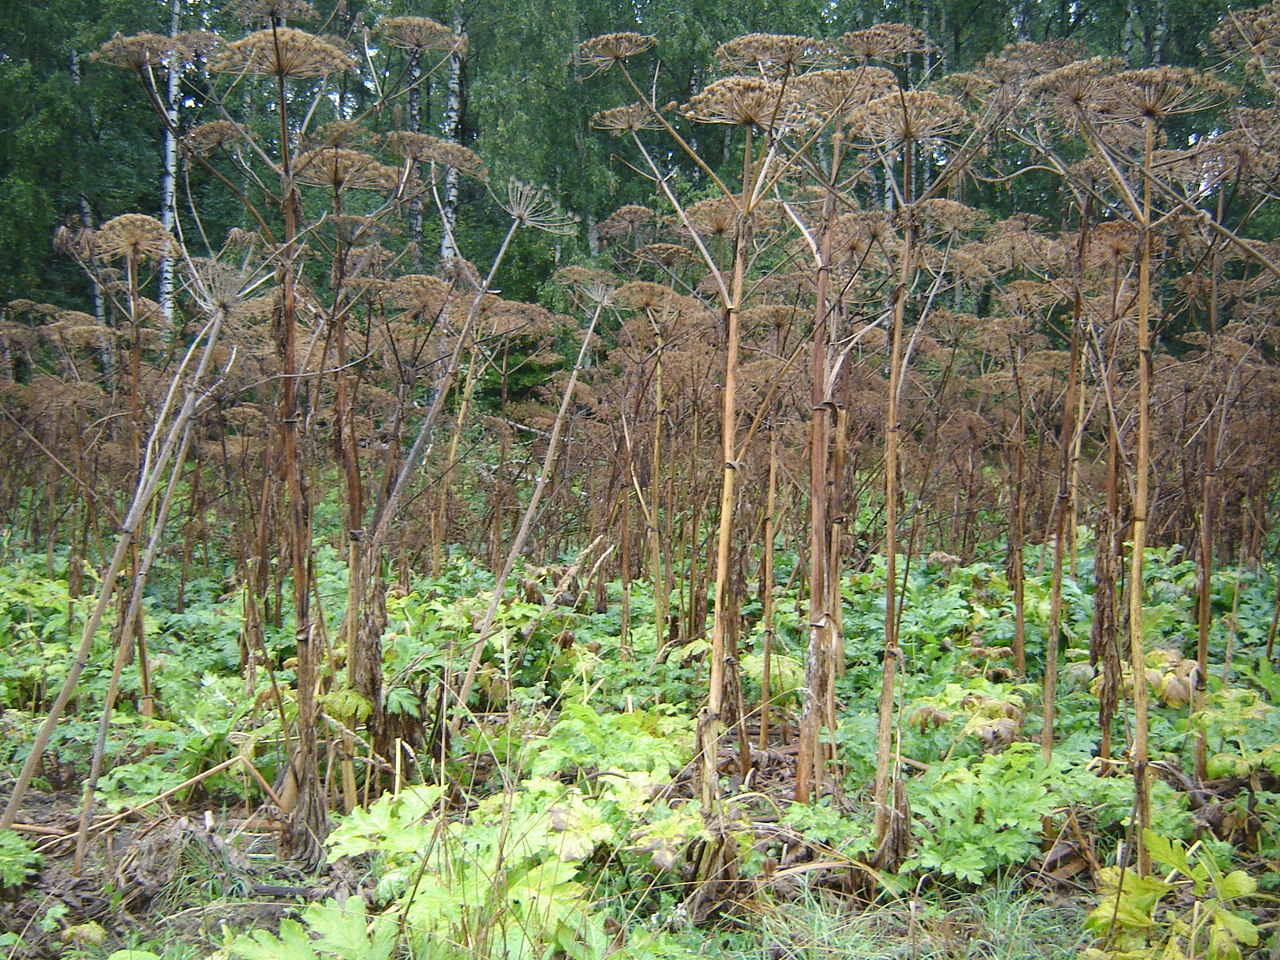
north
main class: Woodland
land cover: Pine dominated mixed woodland
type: hemiboreal forest and nemoral coniferous forest and mixed broadleaved-coniferous forest
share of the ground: > 75 %
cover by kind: broadleaved forest trees 55 %, coniferous forest trees 30 %, herbaceous plants 15 %
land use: Forestry
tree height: > 5 m
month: September
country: LT
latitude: 54.9976
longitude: 25.3638
